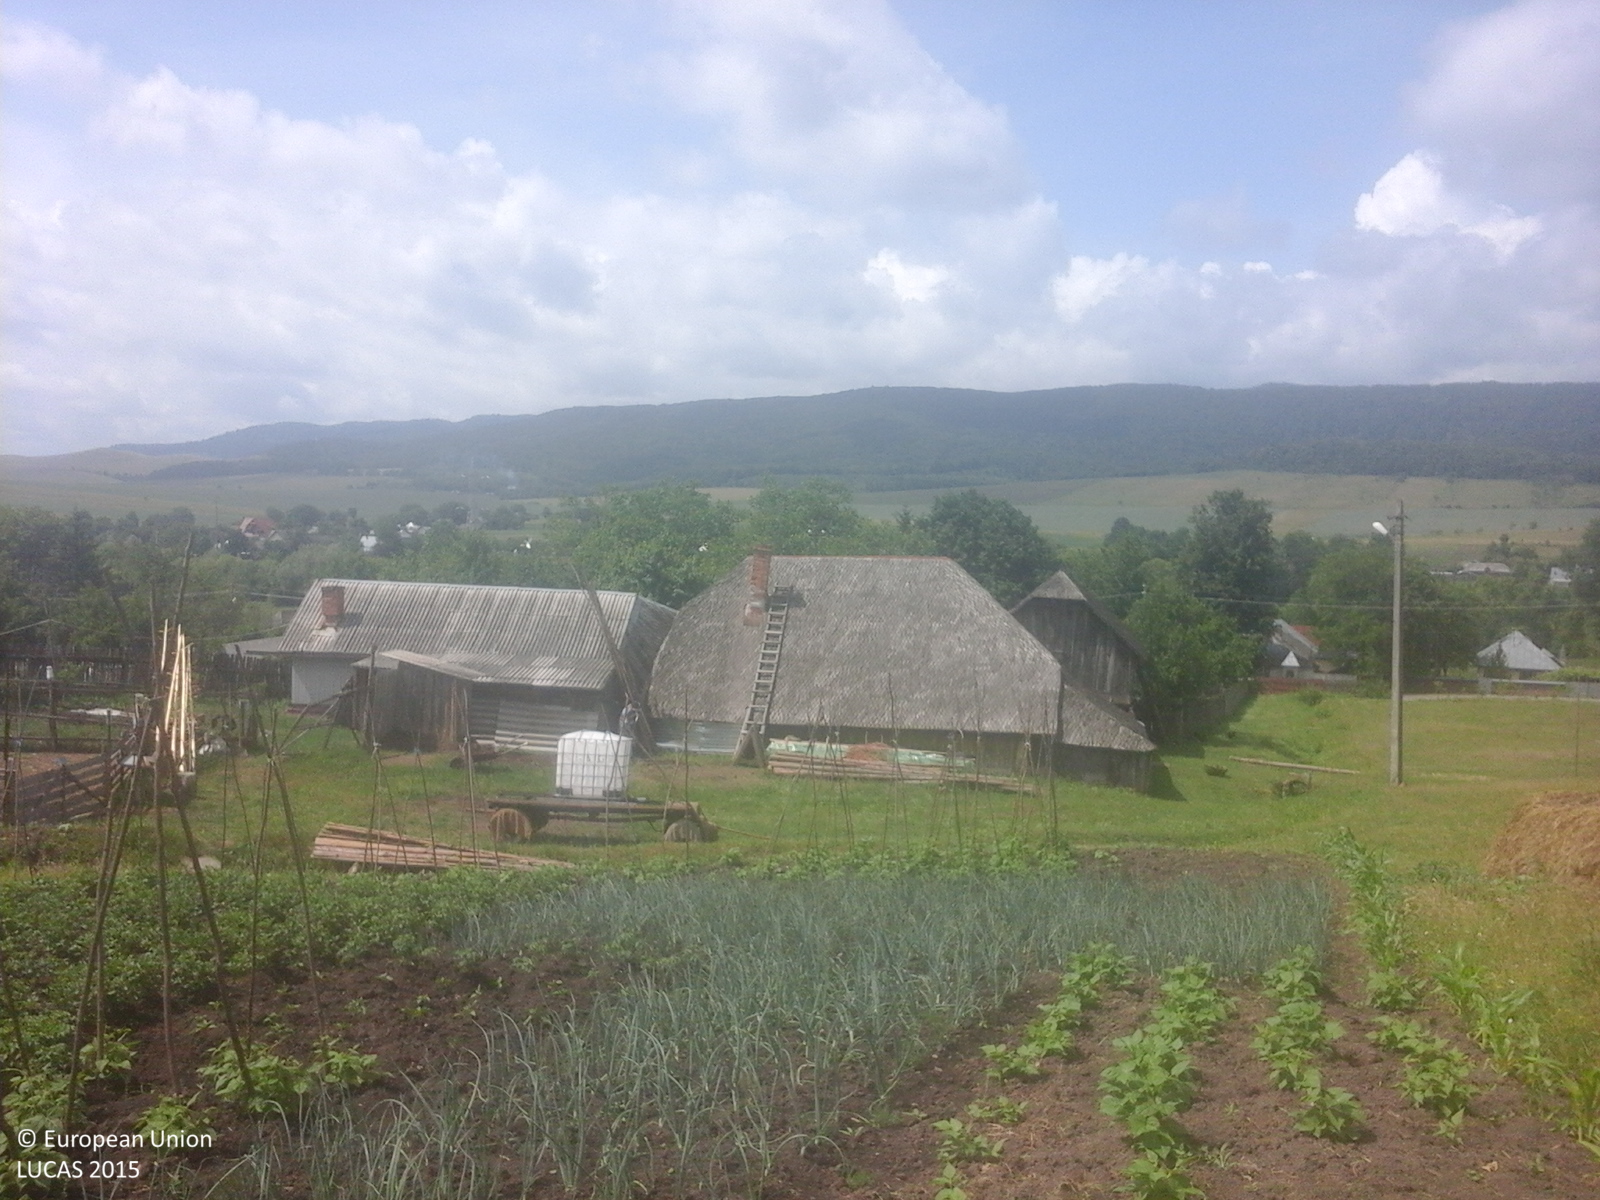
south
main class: Cropland
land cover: Dry pulses
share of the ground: < 10 %
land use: Kitchen garden
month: June
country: RO
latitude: 47.0448
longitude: 26.3637
